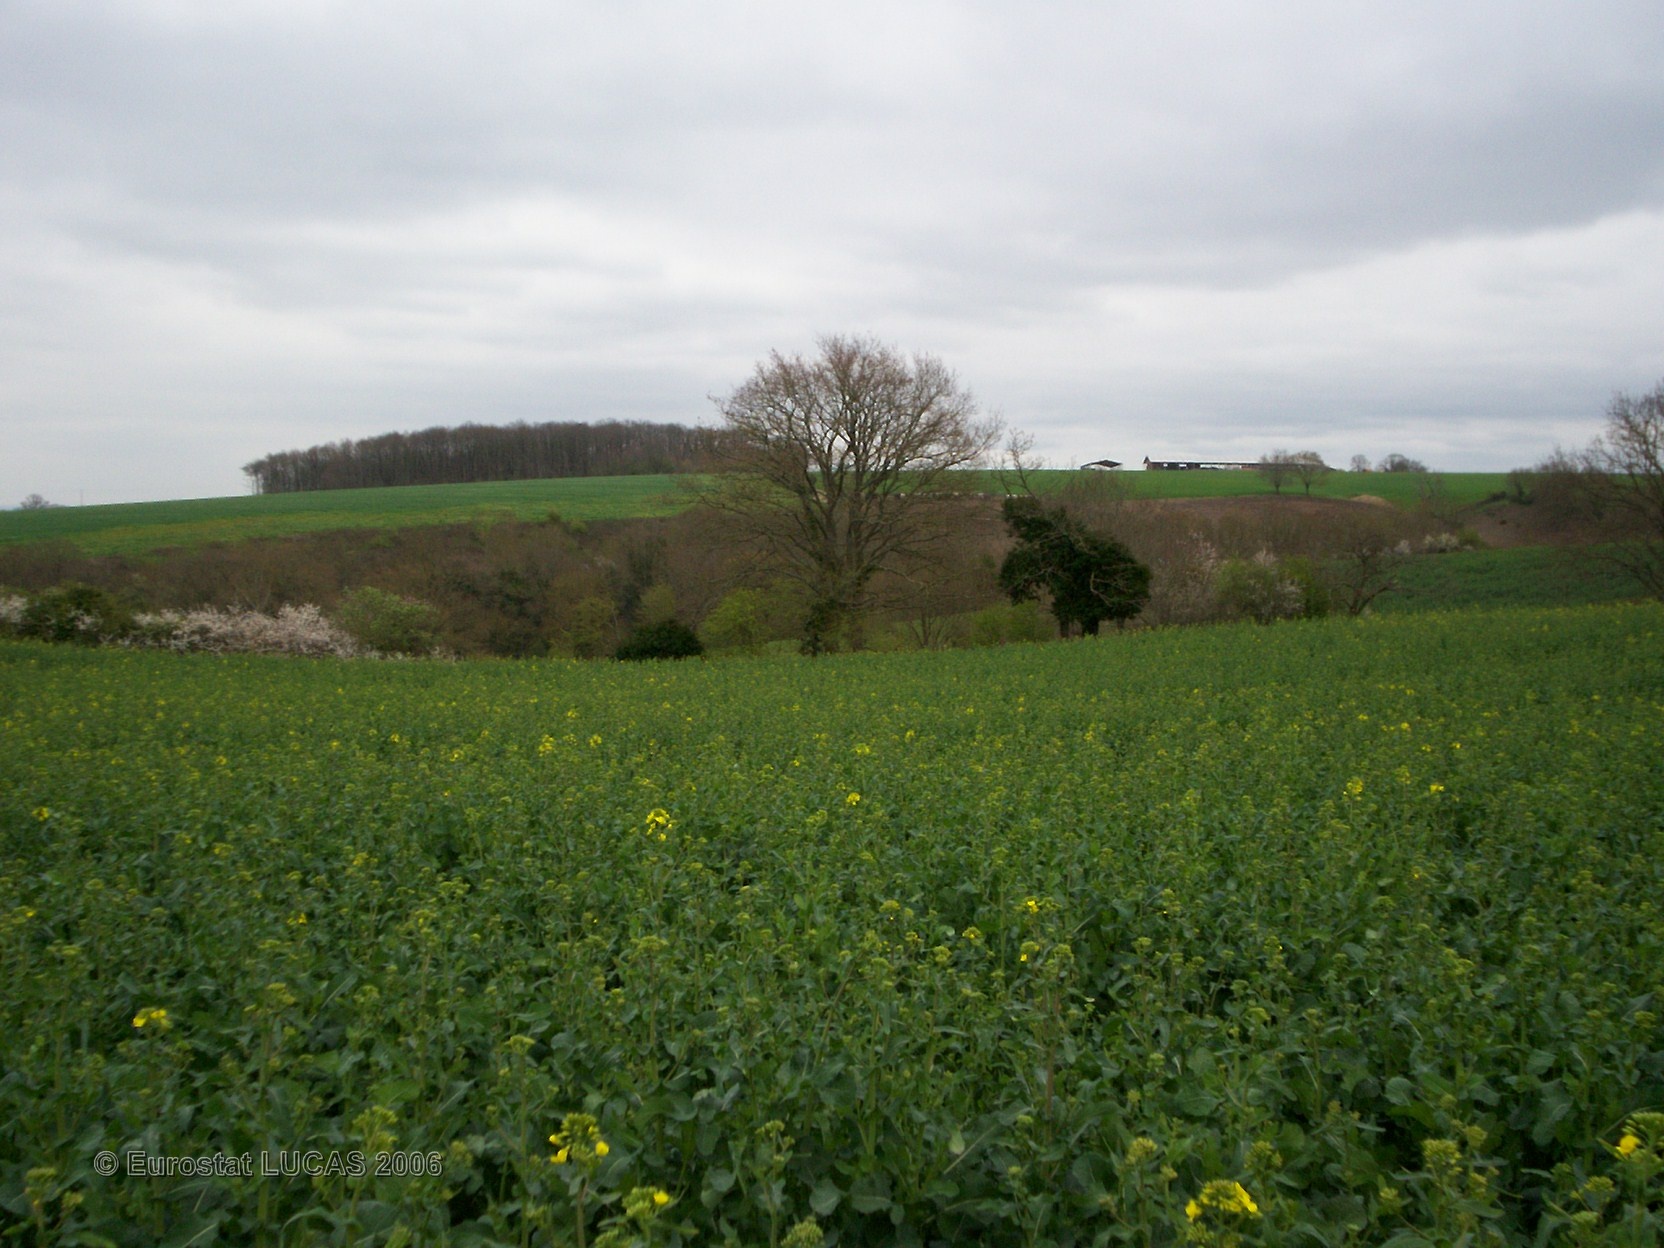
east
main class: Cropland
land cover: Rape and turnip rape
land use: Agriculture (excluding fallow land and kitchen gardens)
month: April
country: FR
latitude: 47.3355
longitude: -1.0873
